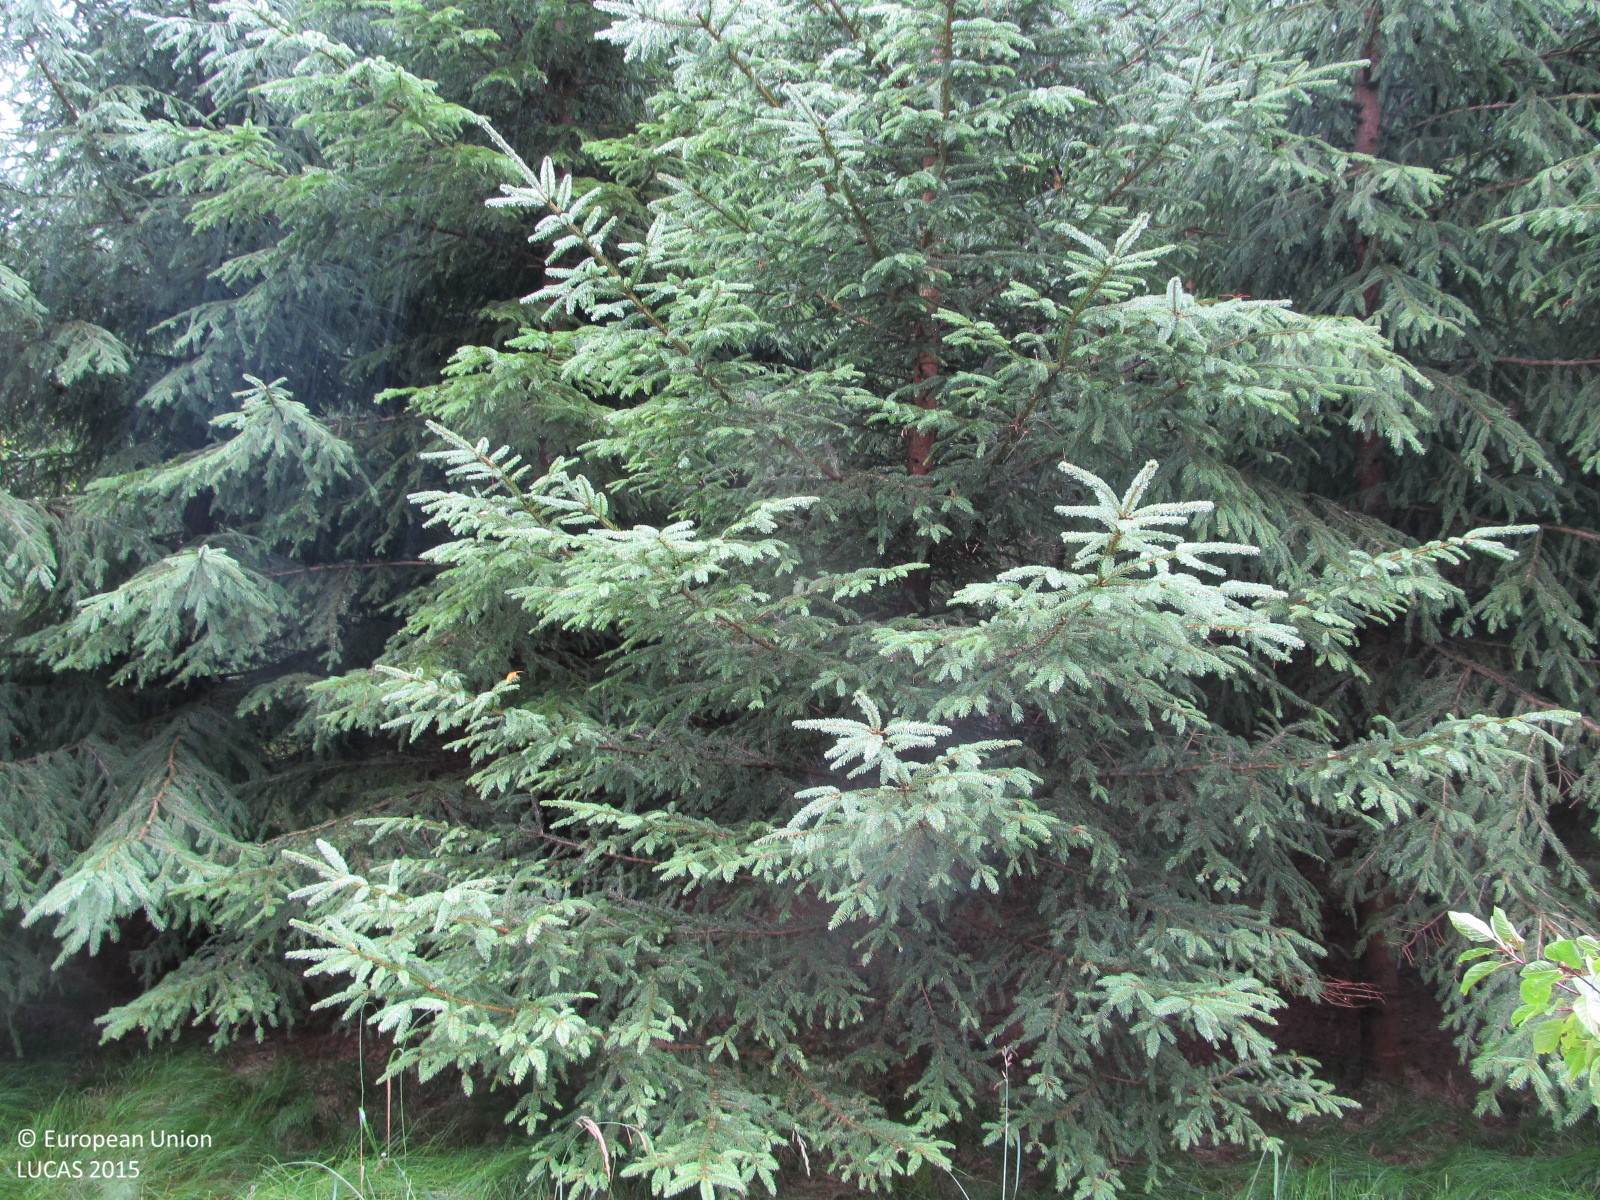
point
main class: Woodland
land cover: Spruce dominated coniferous woodland
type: hemiboreal forest and nemoral coniferous forest and mixed broadleaved-coniferous forest
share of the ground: > 75 %
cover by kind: coniferous forest trees 80 %, herbaceous plants 20 %
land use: Forestry
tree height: > 5 m
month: August
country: AT
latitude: 48.7006
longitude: 15.0973
